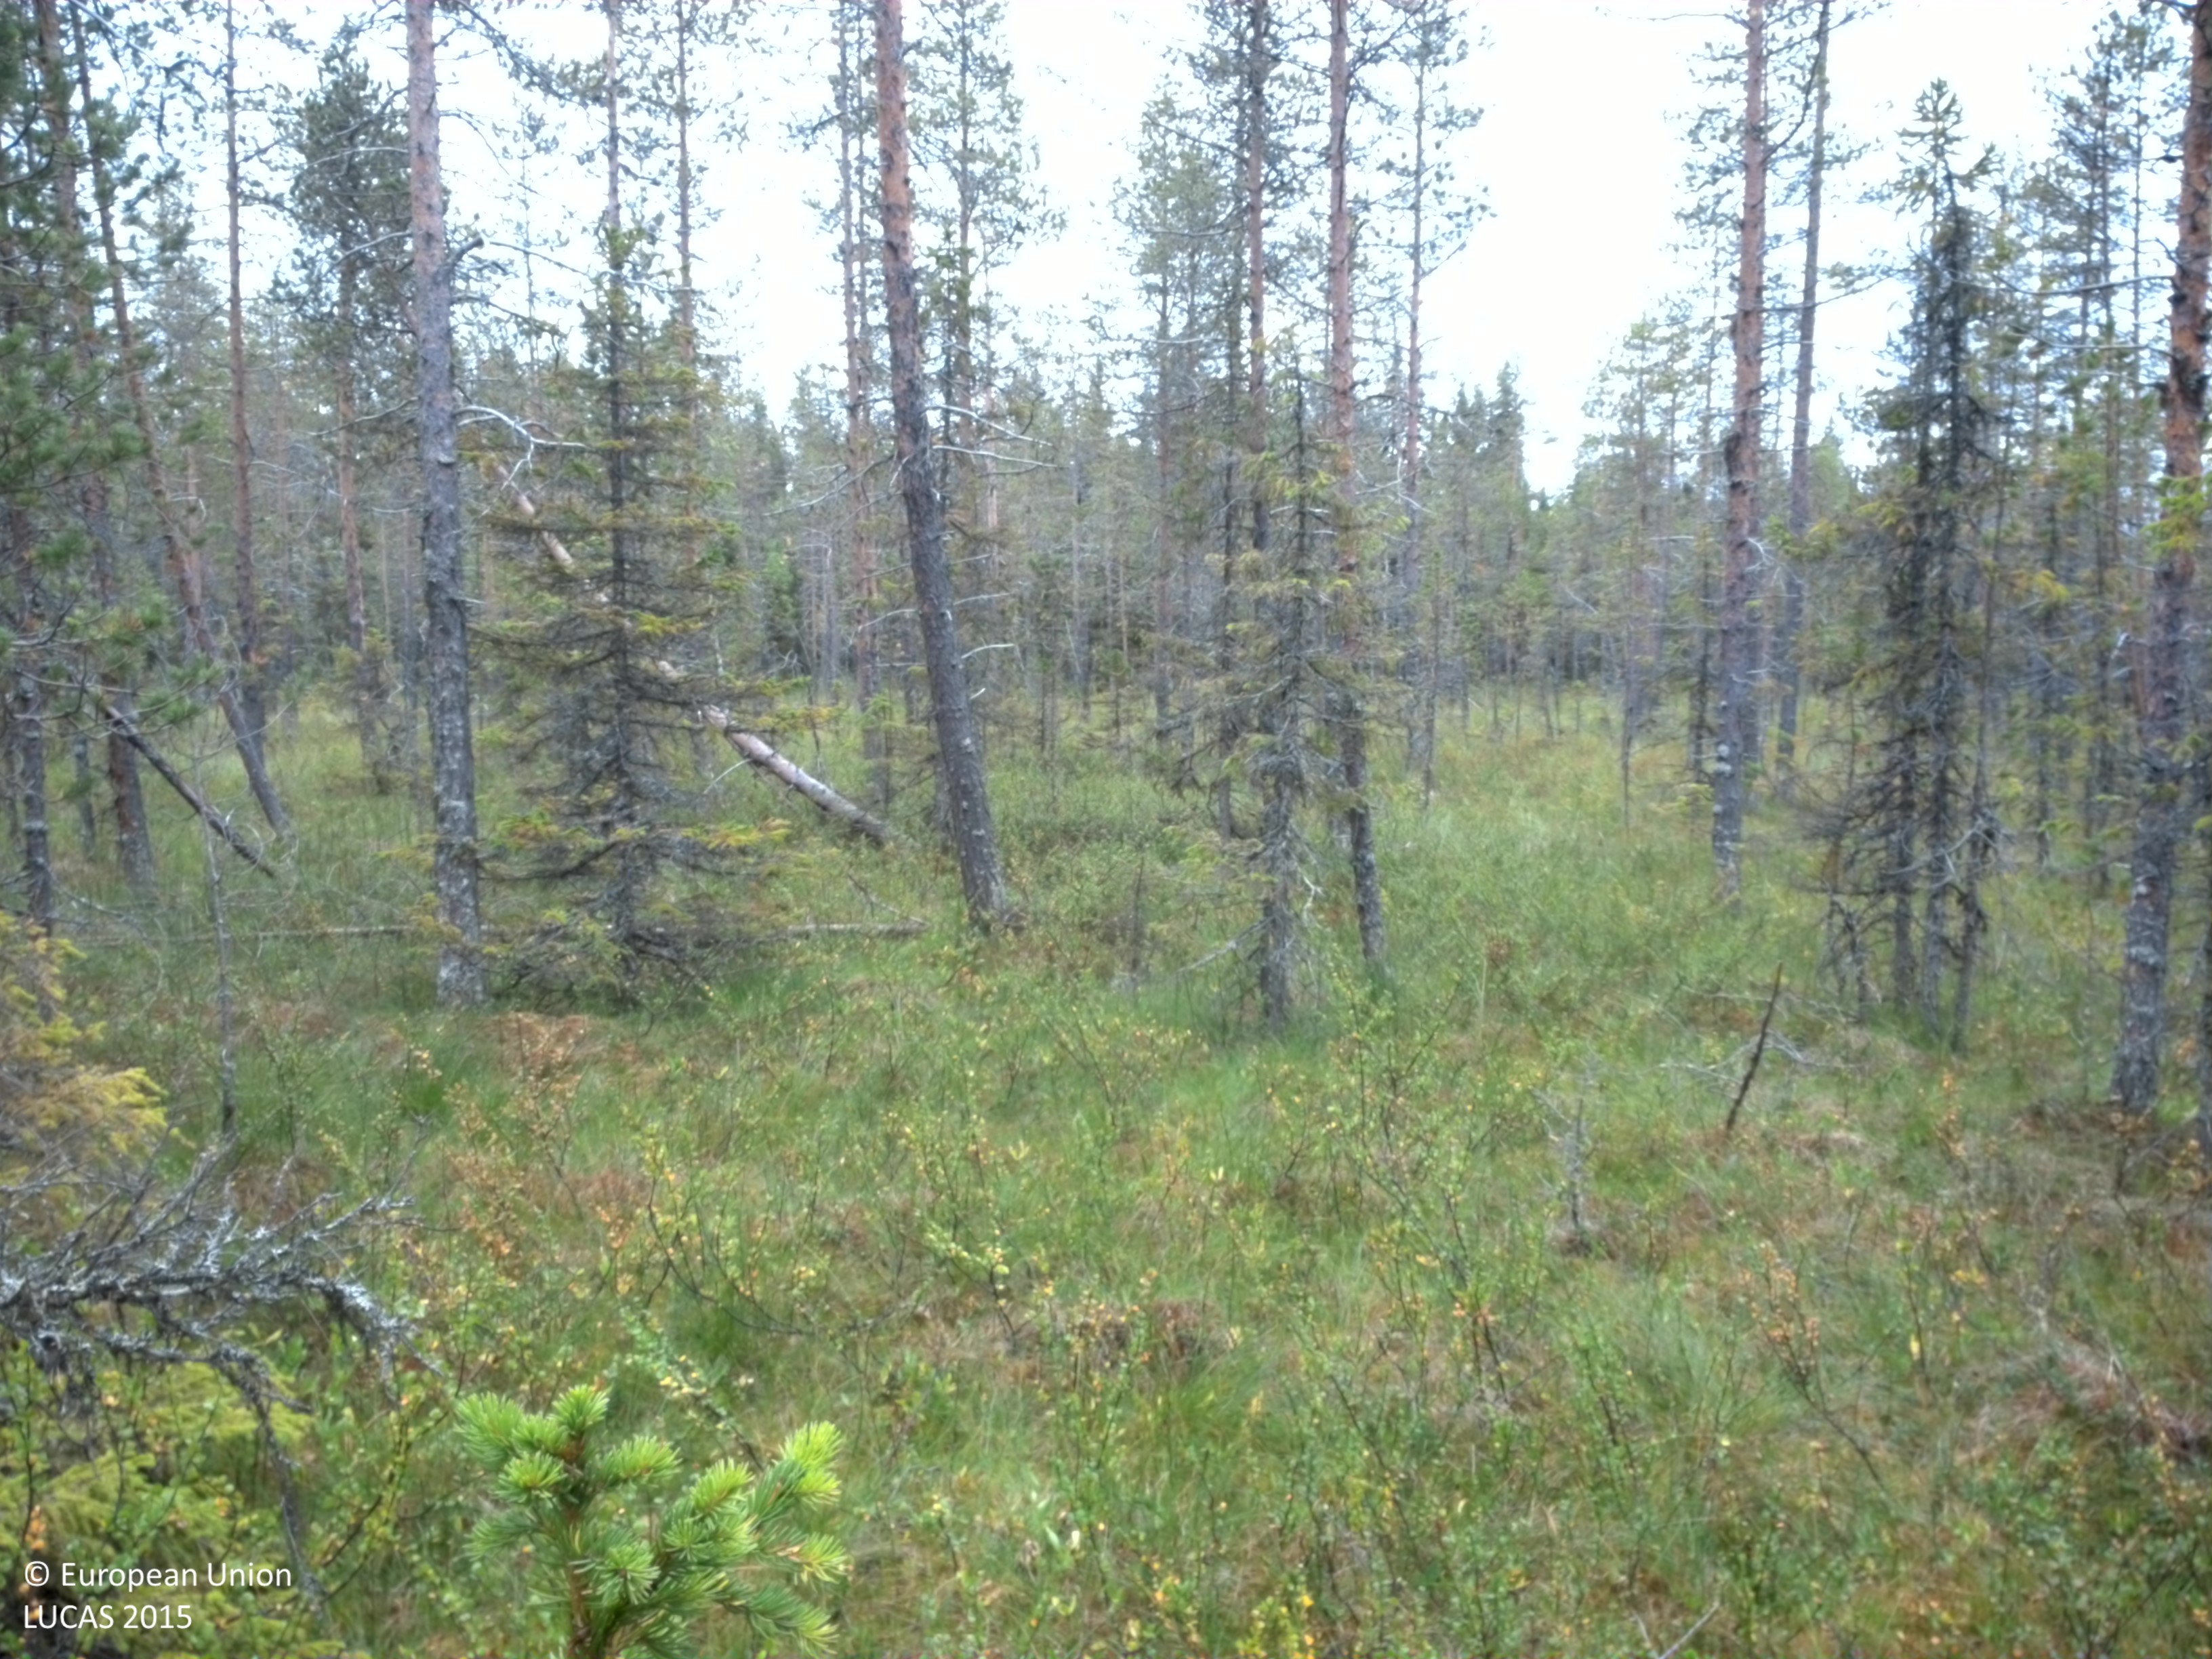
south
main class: Woodland
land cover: Pine dominated coniferous woodland
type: mire and swamp forests
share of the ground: 10 - 25 %
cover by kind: lichens and mosses 35 %, herbaceous plants 30 %, coniferous forest trees 20 %, shrubs 15 %
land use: Semi-natural and natural areas not in use
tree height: > 5 m
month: August
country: SE
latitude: 64.7476
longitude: 16.6678
